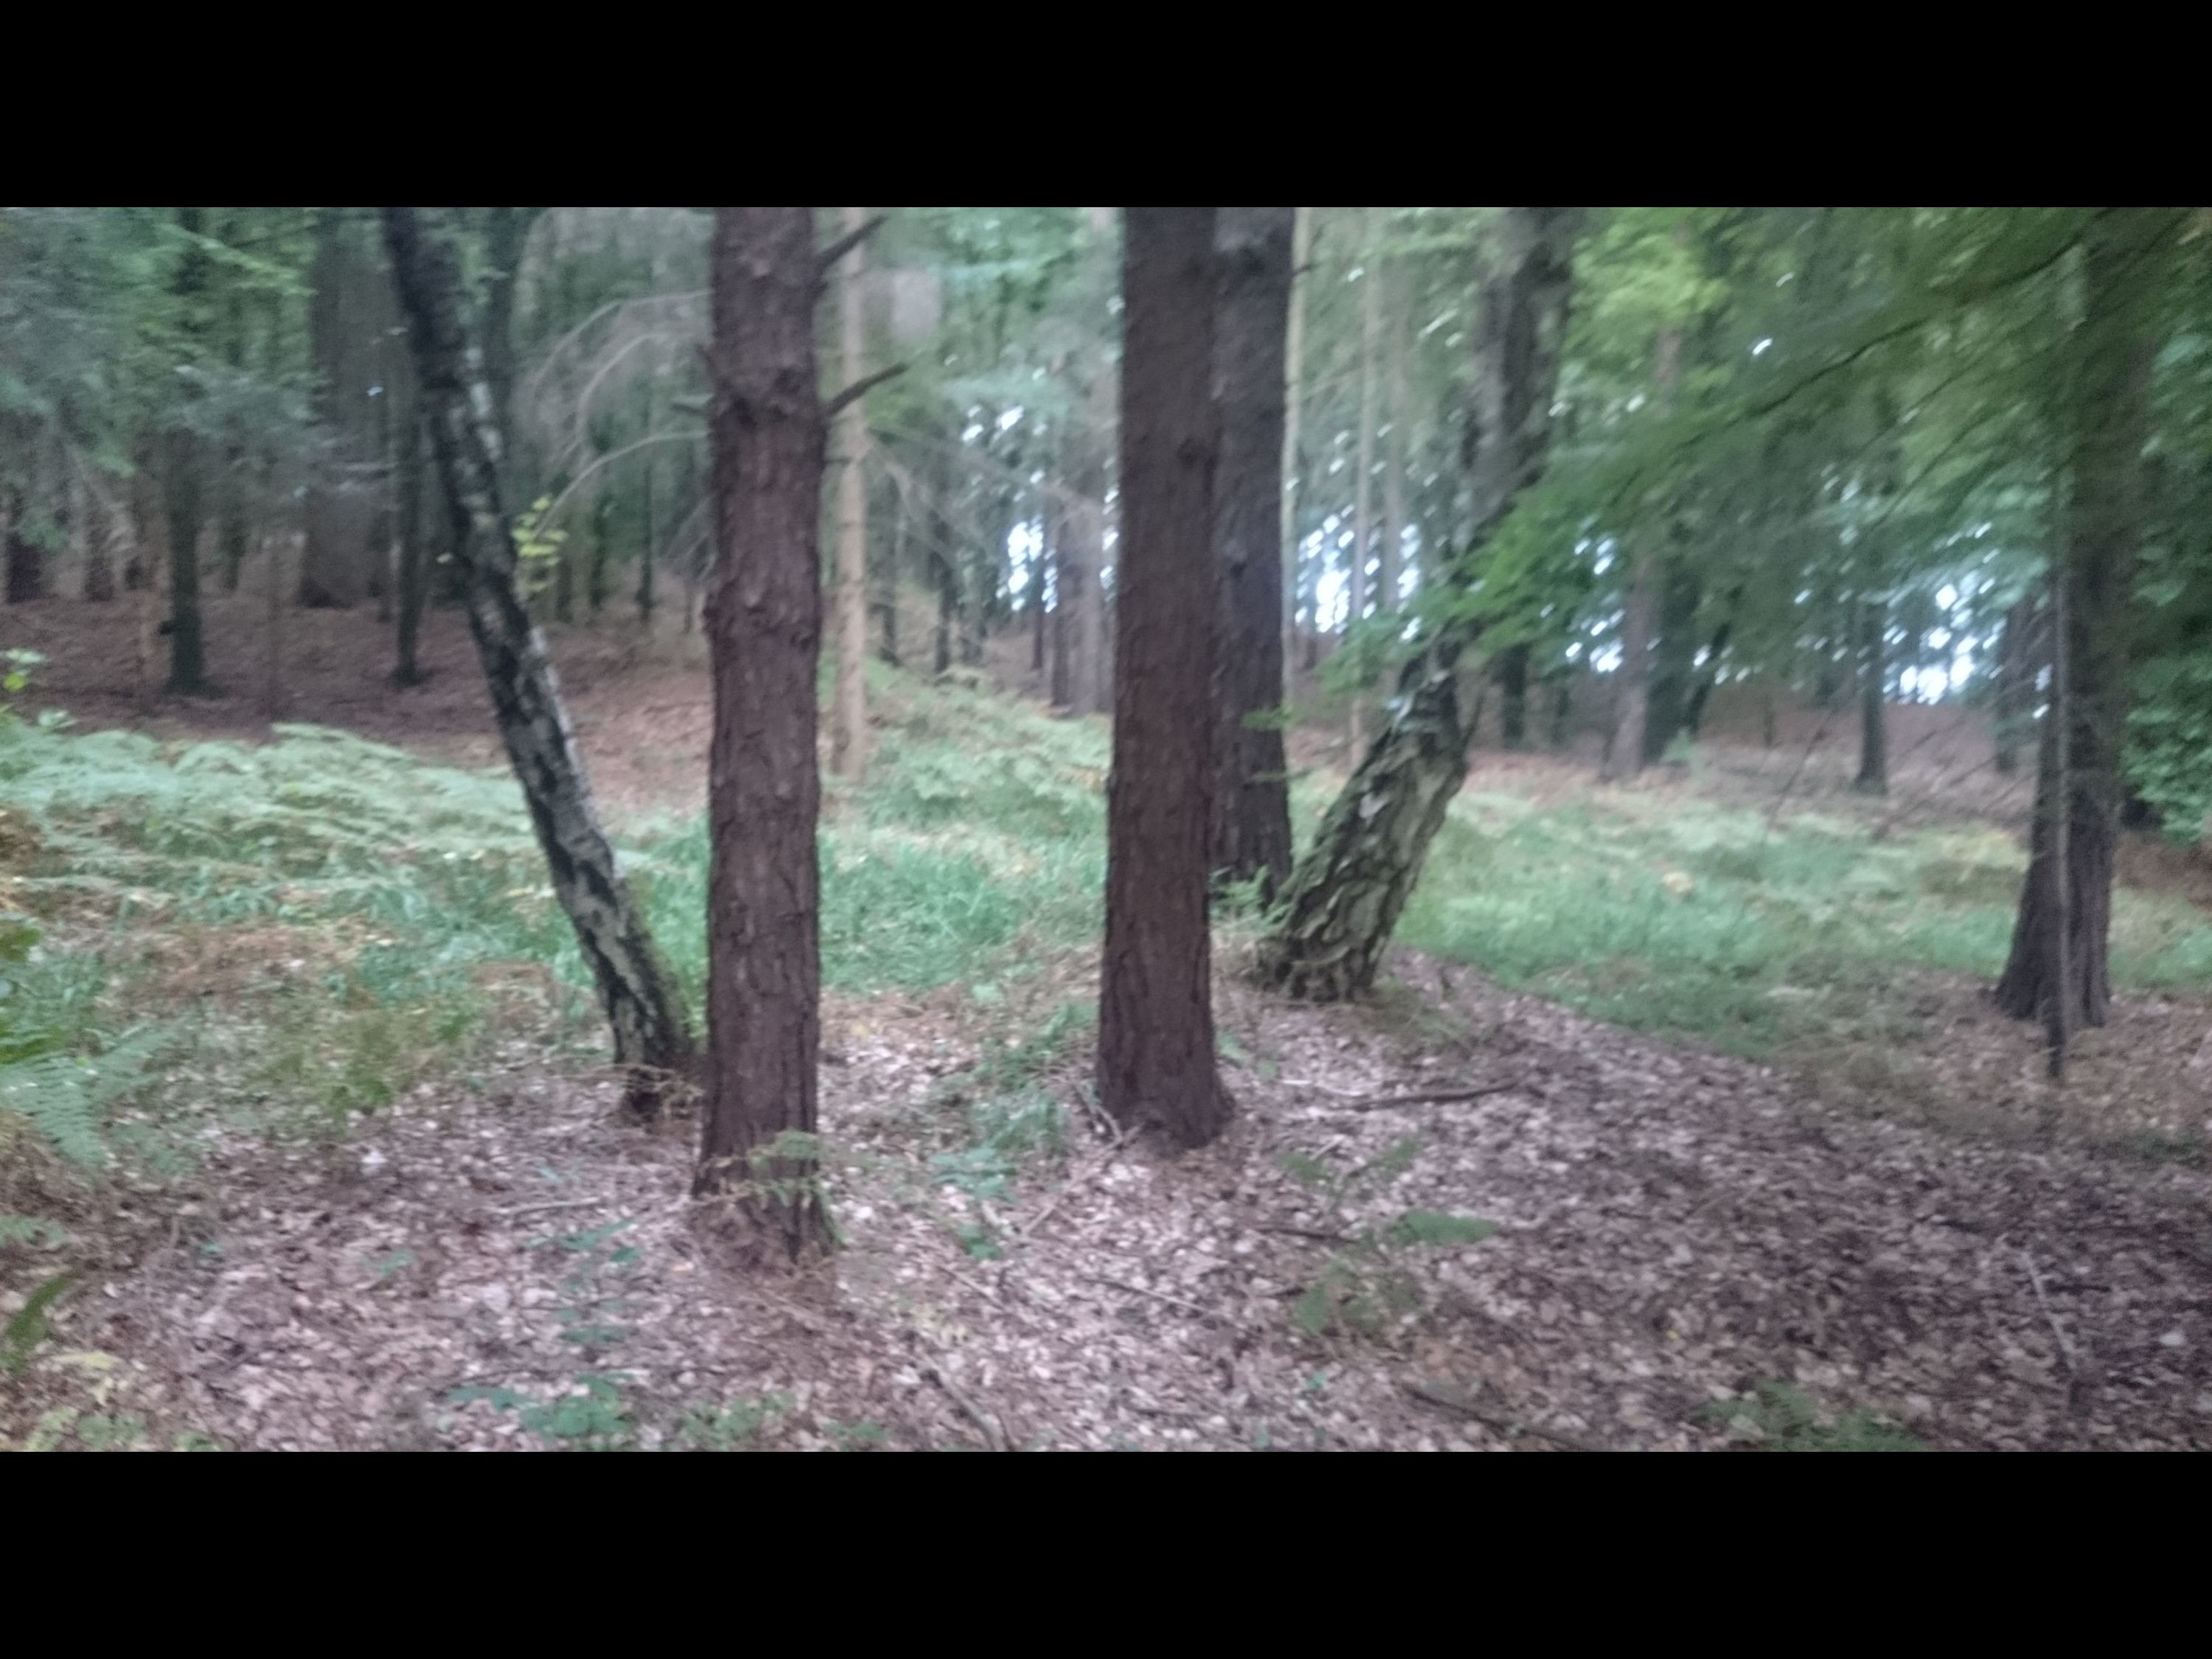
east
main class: Woodland
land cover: Other mixed woodland
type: hemiboreal forest and nemoral coniferous forest and mixed broadleaved-coniferous forest
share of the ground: > 75 %
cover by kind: coniferous forest trees 60 %, broadleaved forest trees 30 %, unconsolidated bare surface 10 %
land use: Forestry
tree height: > 5 m
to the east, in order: Other mixed woodland; Tracks; Spruce dominated coniferous woodland; Pine dominated mixed woodland; Paved roads, cycling and walking lanes; Pine dominated mixed woodland; Broadleaved woodland; Ditches and canals; Paved roads, cycling and walking lanes; Shruby margins; Fences; Other fruit trees and berries; Apple fruit
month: July
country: AT
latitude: 46.9962
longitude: 15.9843
